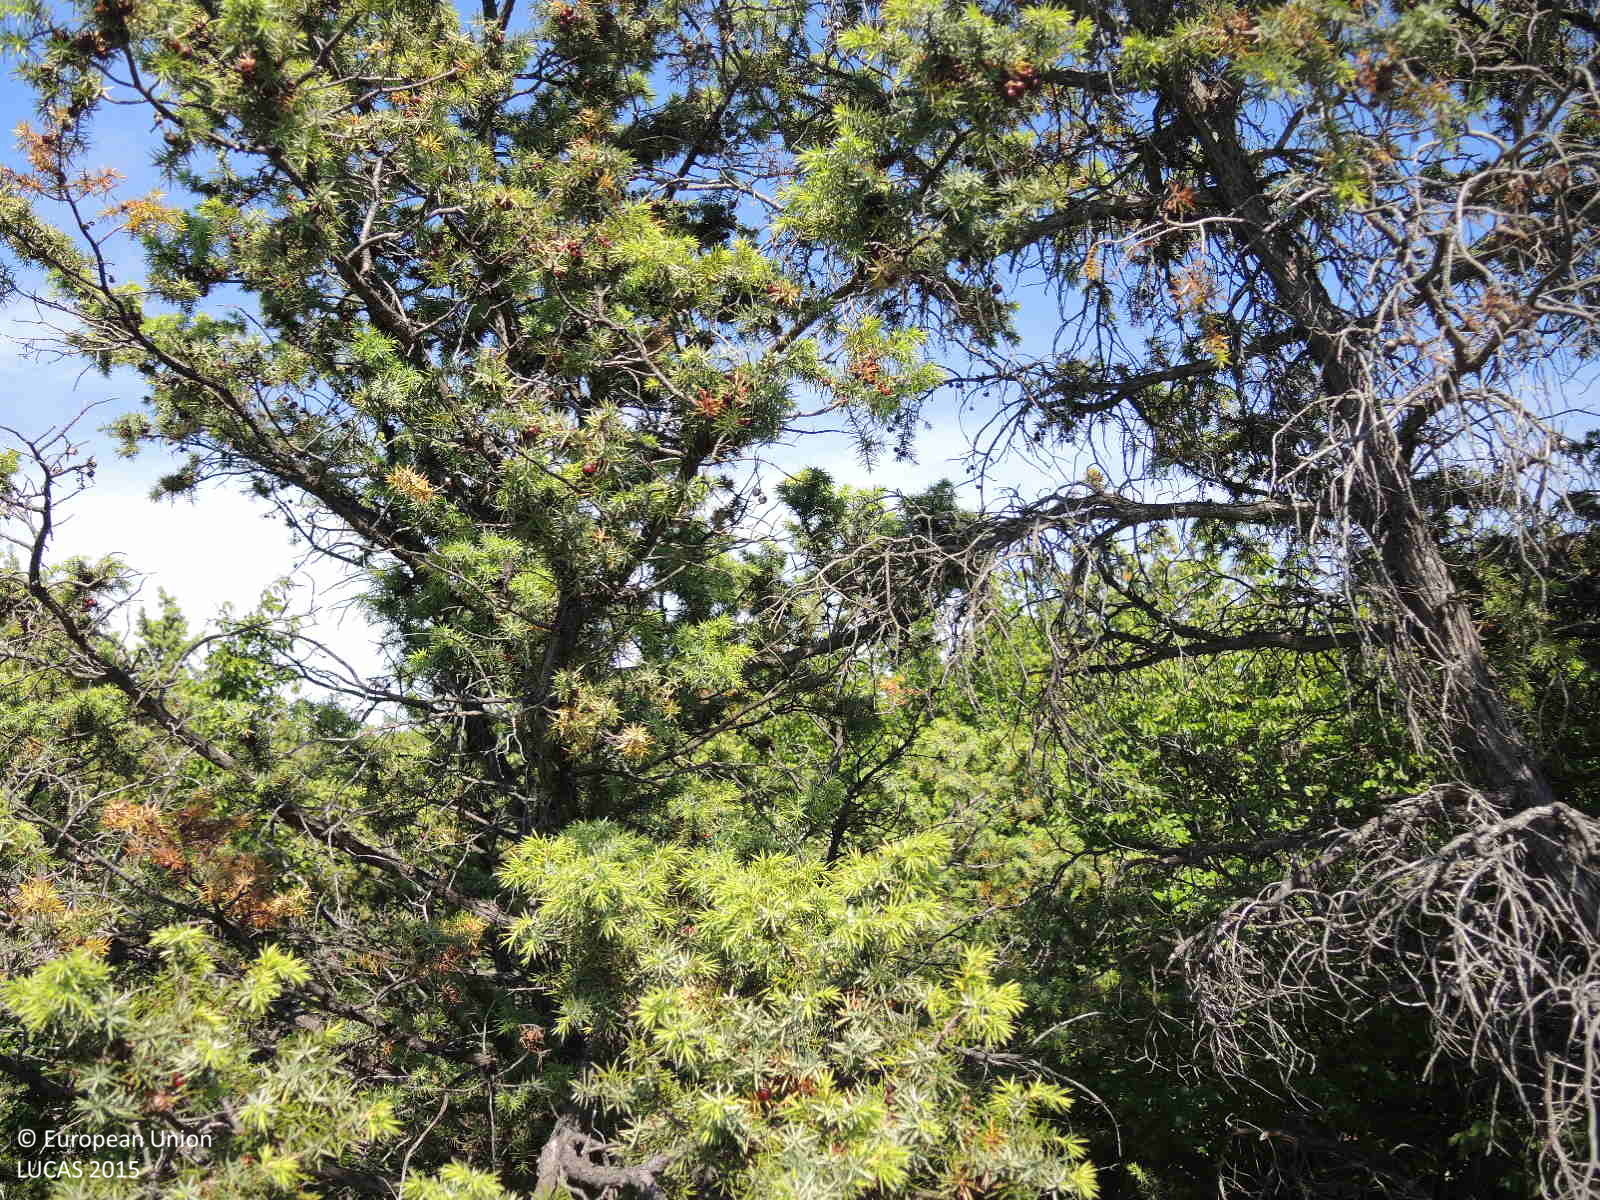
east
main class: Shrubland
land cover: Shrubland with sparse tree cover
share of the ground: > 75 %
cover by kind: shrubs 85 %, coniferous forest trees 5 %, herbaceous plants 5 %, unconsolidated bare surface 5 %
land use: Semi-natural and natural areas not in use
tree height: < 5 m
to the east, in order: Shrubland with sparse tree cover
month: May
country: HR
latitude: 43.9456
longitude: 15.9350
